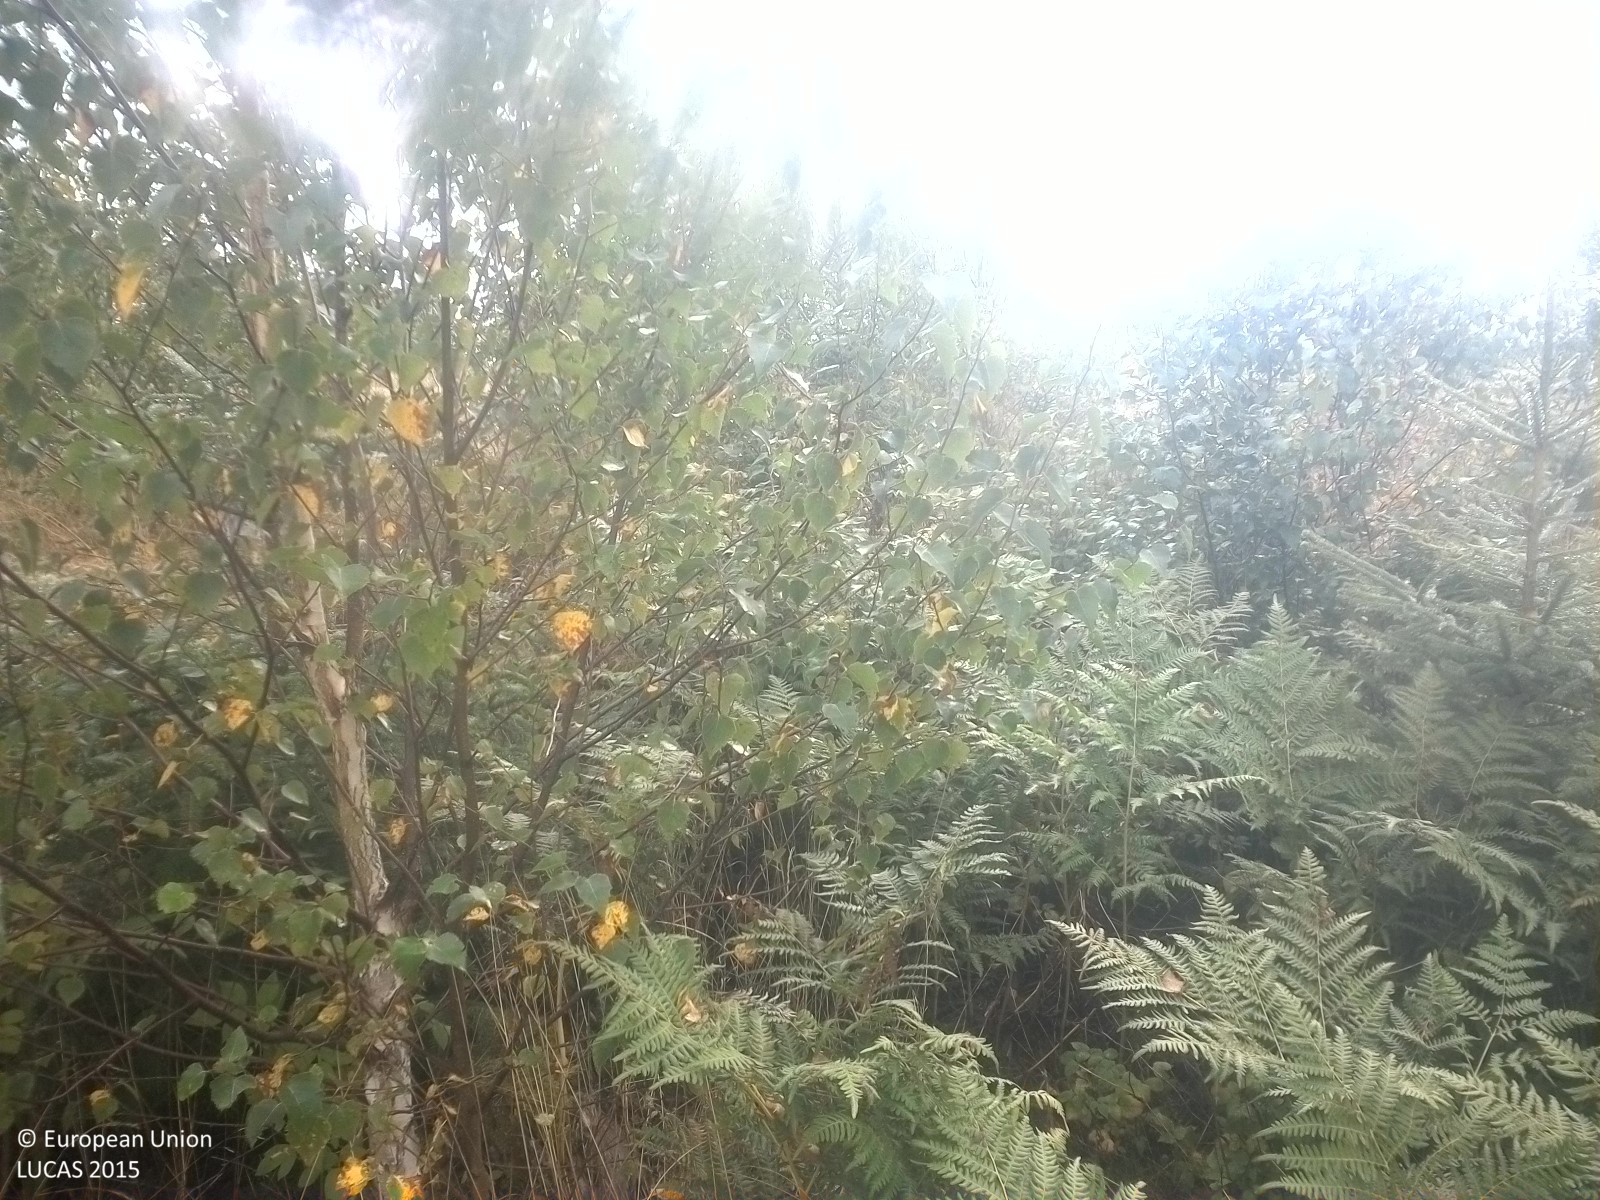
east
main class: Woodland
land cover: Spruce dominated mixed woodland
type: boreal forest
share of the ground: 25 - 50 %
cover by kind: herbaceous plants 35 %, coniferous forest trees 20 %, broadleaved forest trees 20 %, shrubs 10 %, lichens and mosses 10 %, consolidated bare surface 5 %
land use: Forestry
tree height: < 5 m
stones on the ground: 25 - 50 %
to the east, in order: Spruce dominated mixed woodland; Broadleaved woodland; Paved roads, cycling and walking lanes; Ditches and canals; Abandoned hedges; Oats; Broadleaved woodland; Tracks; Ditches and canals; Oats; Ditches and canals
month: September
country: SE
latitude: 59.3626
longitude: 15.6742
